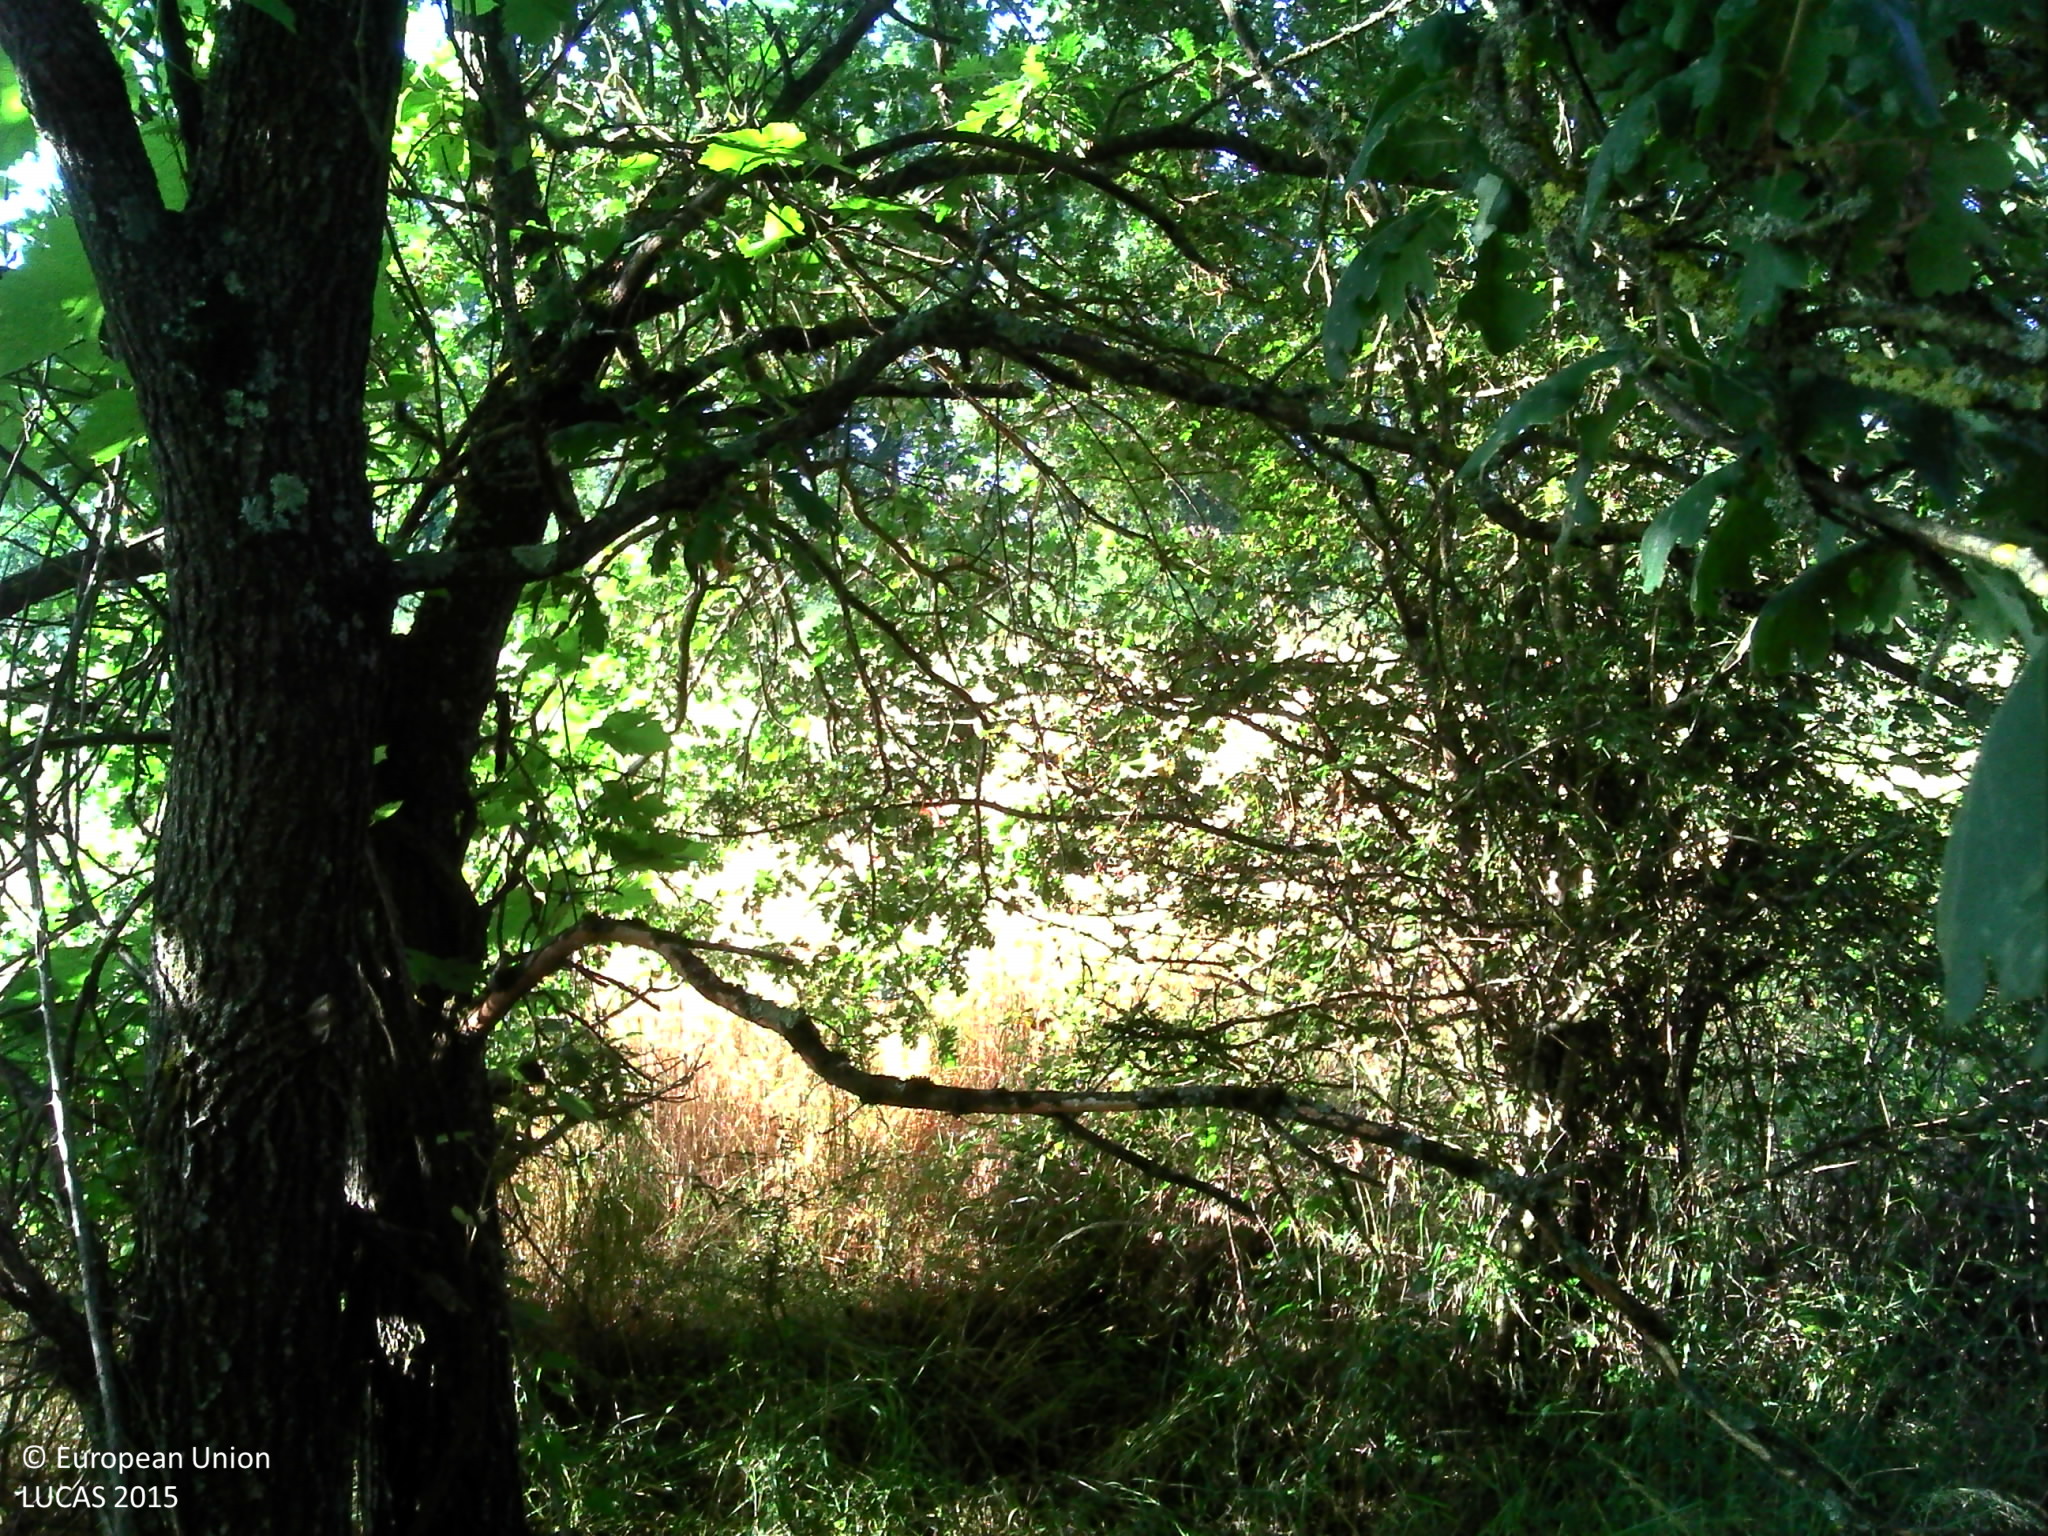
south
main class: Shrubland
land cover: Shrubland with sparse tree cover
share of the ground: > 75 %
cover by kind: herbaceous plants 50 %, shrubs 45 %, broadleaved forest trees 5 %
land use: Semi-natural and natural areas not in use
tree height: > 5 m
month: June
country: FR
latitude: 43.6410
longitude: 1.3119
